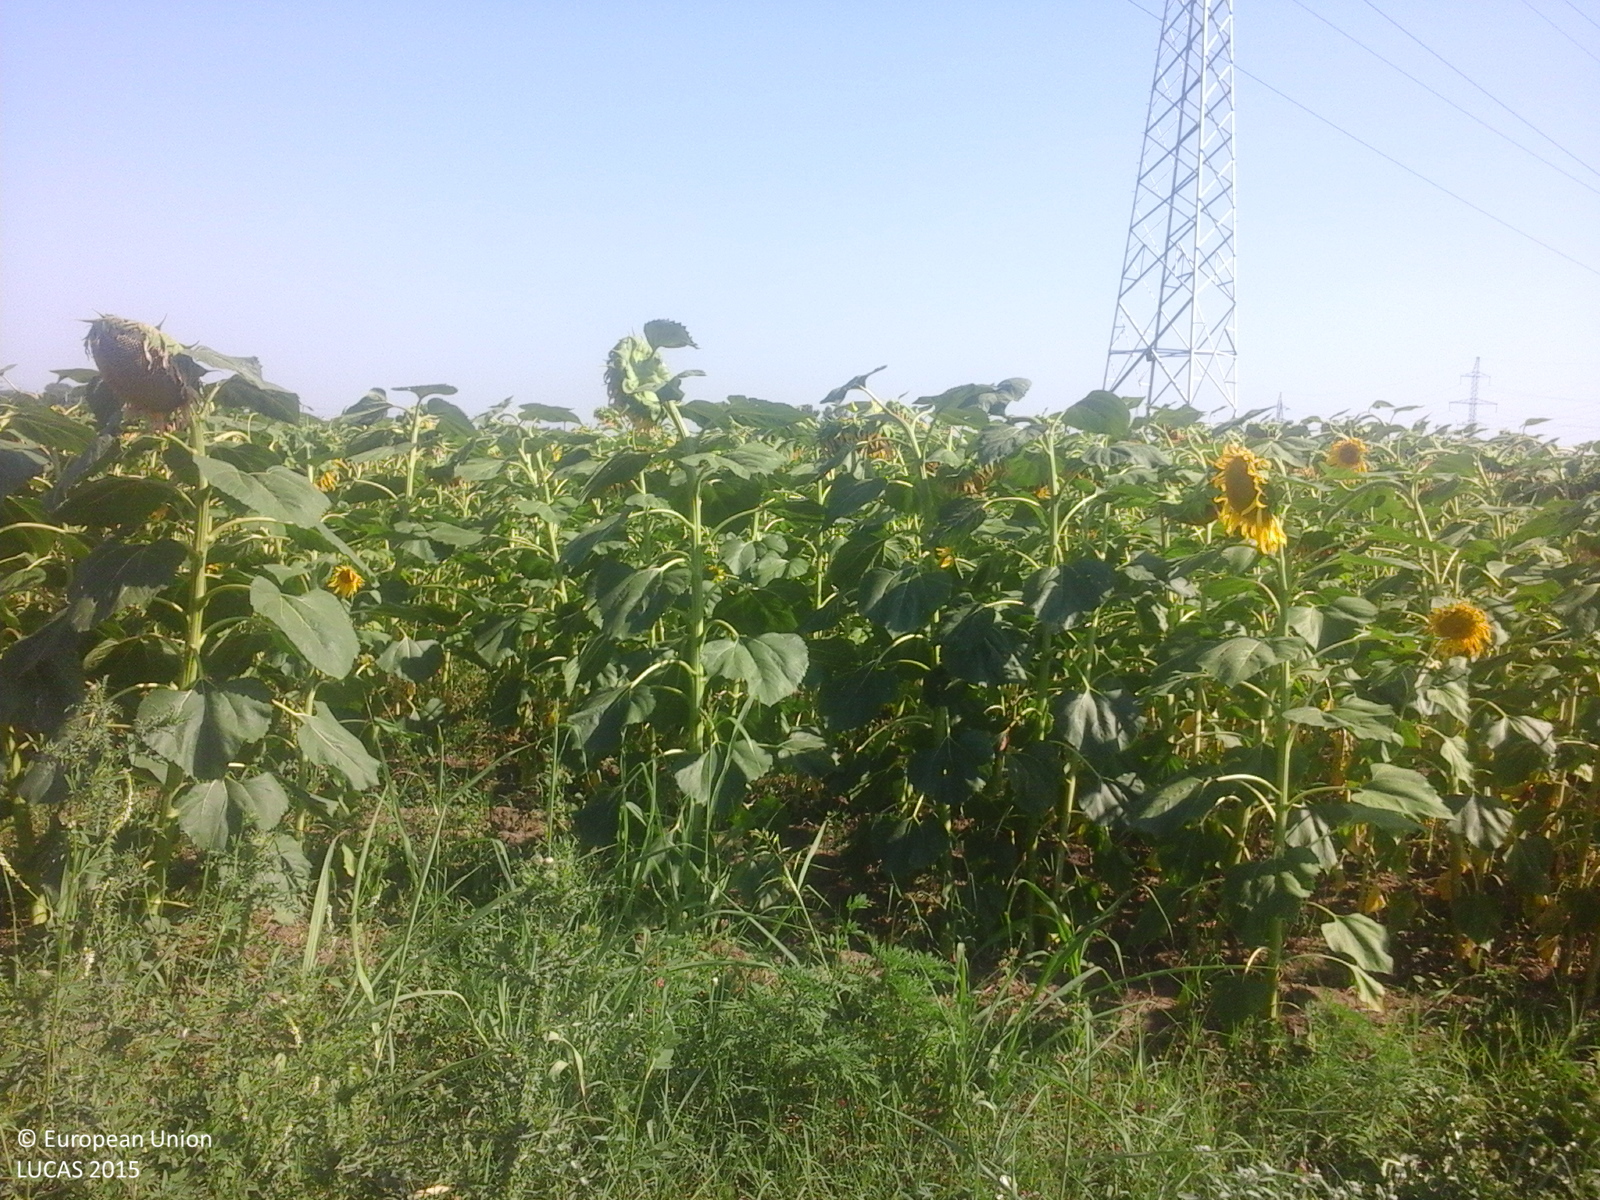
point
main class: Cropland
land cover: Sunflower
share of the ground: > 75 %
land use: Agriculture (excluding fallow land and kitchen gardens)
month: July
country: RO
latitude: 44.1986
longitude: 27.3656
